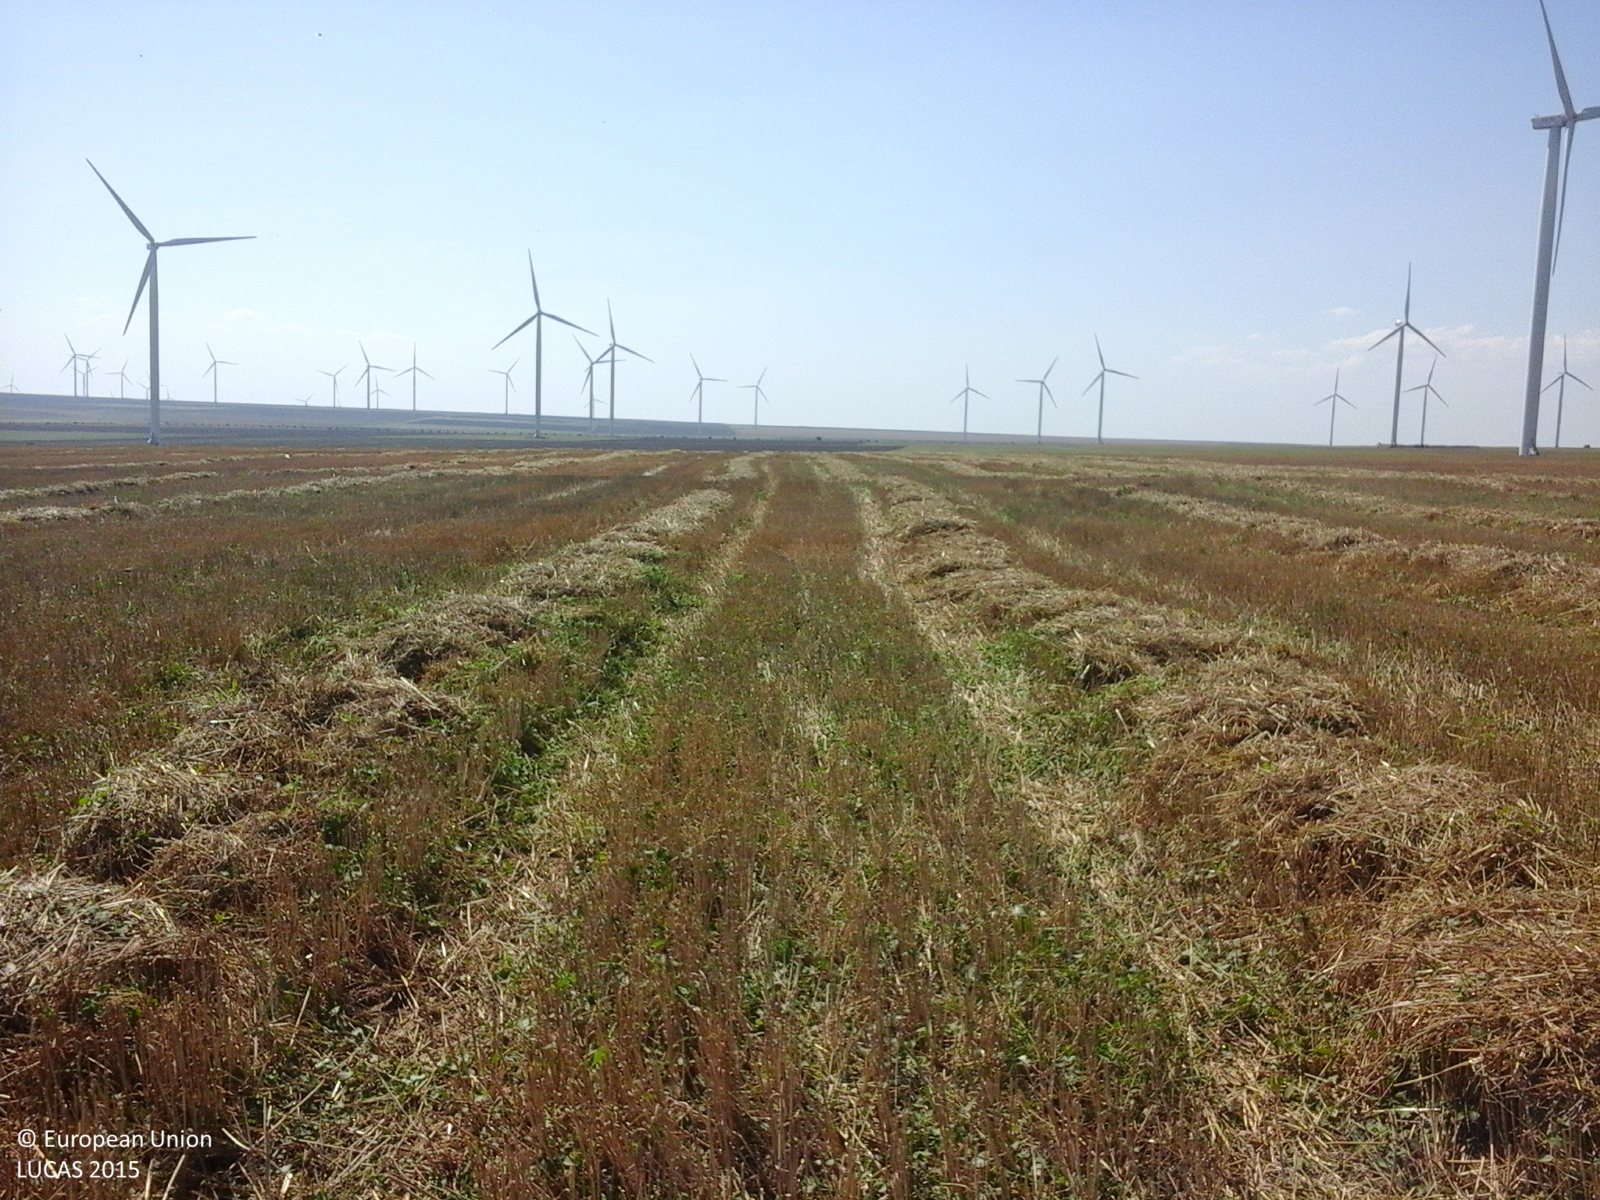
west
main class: Cropland
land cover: Common wheat
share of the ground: > 75 %
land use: Agriculture (excluding fallow land and kitchen gardens)
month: August
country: RO
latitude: 44.5804
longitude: 28.5515
